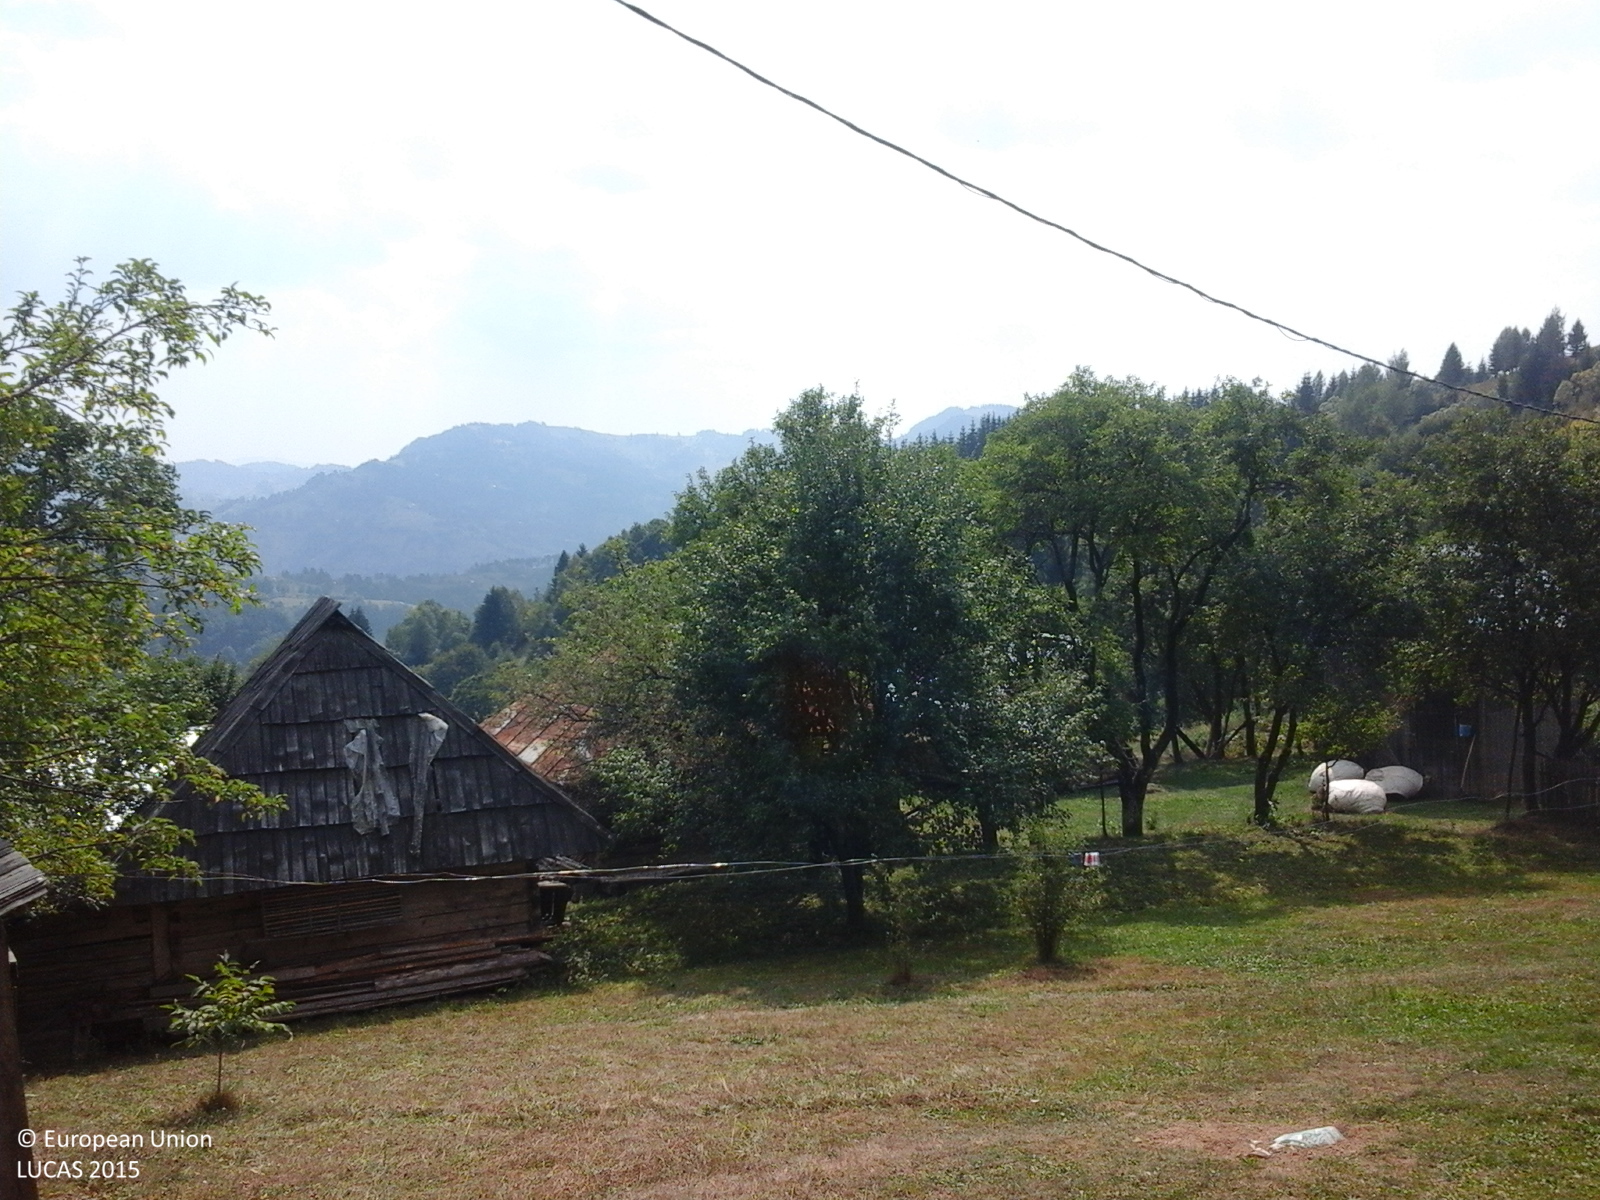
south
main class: Cropland
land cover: Apple fruit
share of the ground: 10 - 25 %
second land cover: Grassland without tree/shrub cover
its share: > 75 %
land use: Agriculture (excluding fallow land and kitchen gardens)
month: September
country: RO
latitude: 47.8521
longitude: 24.4344
